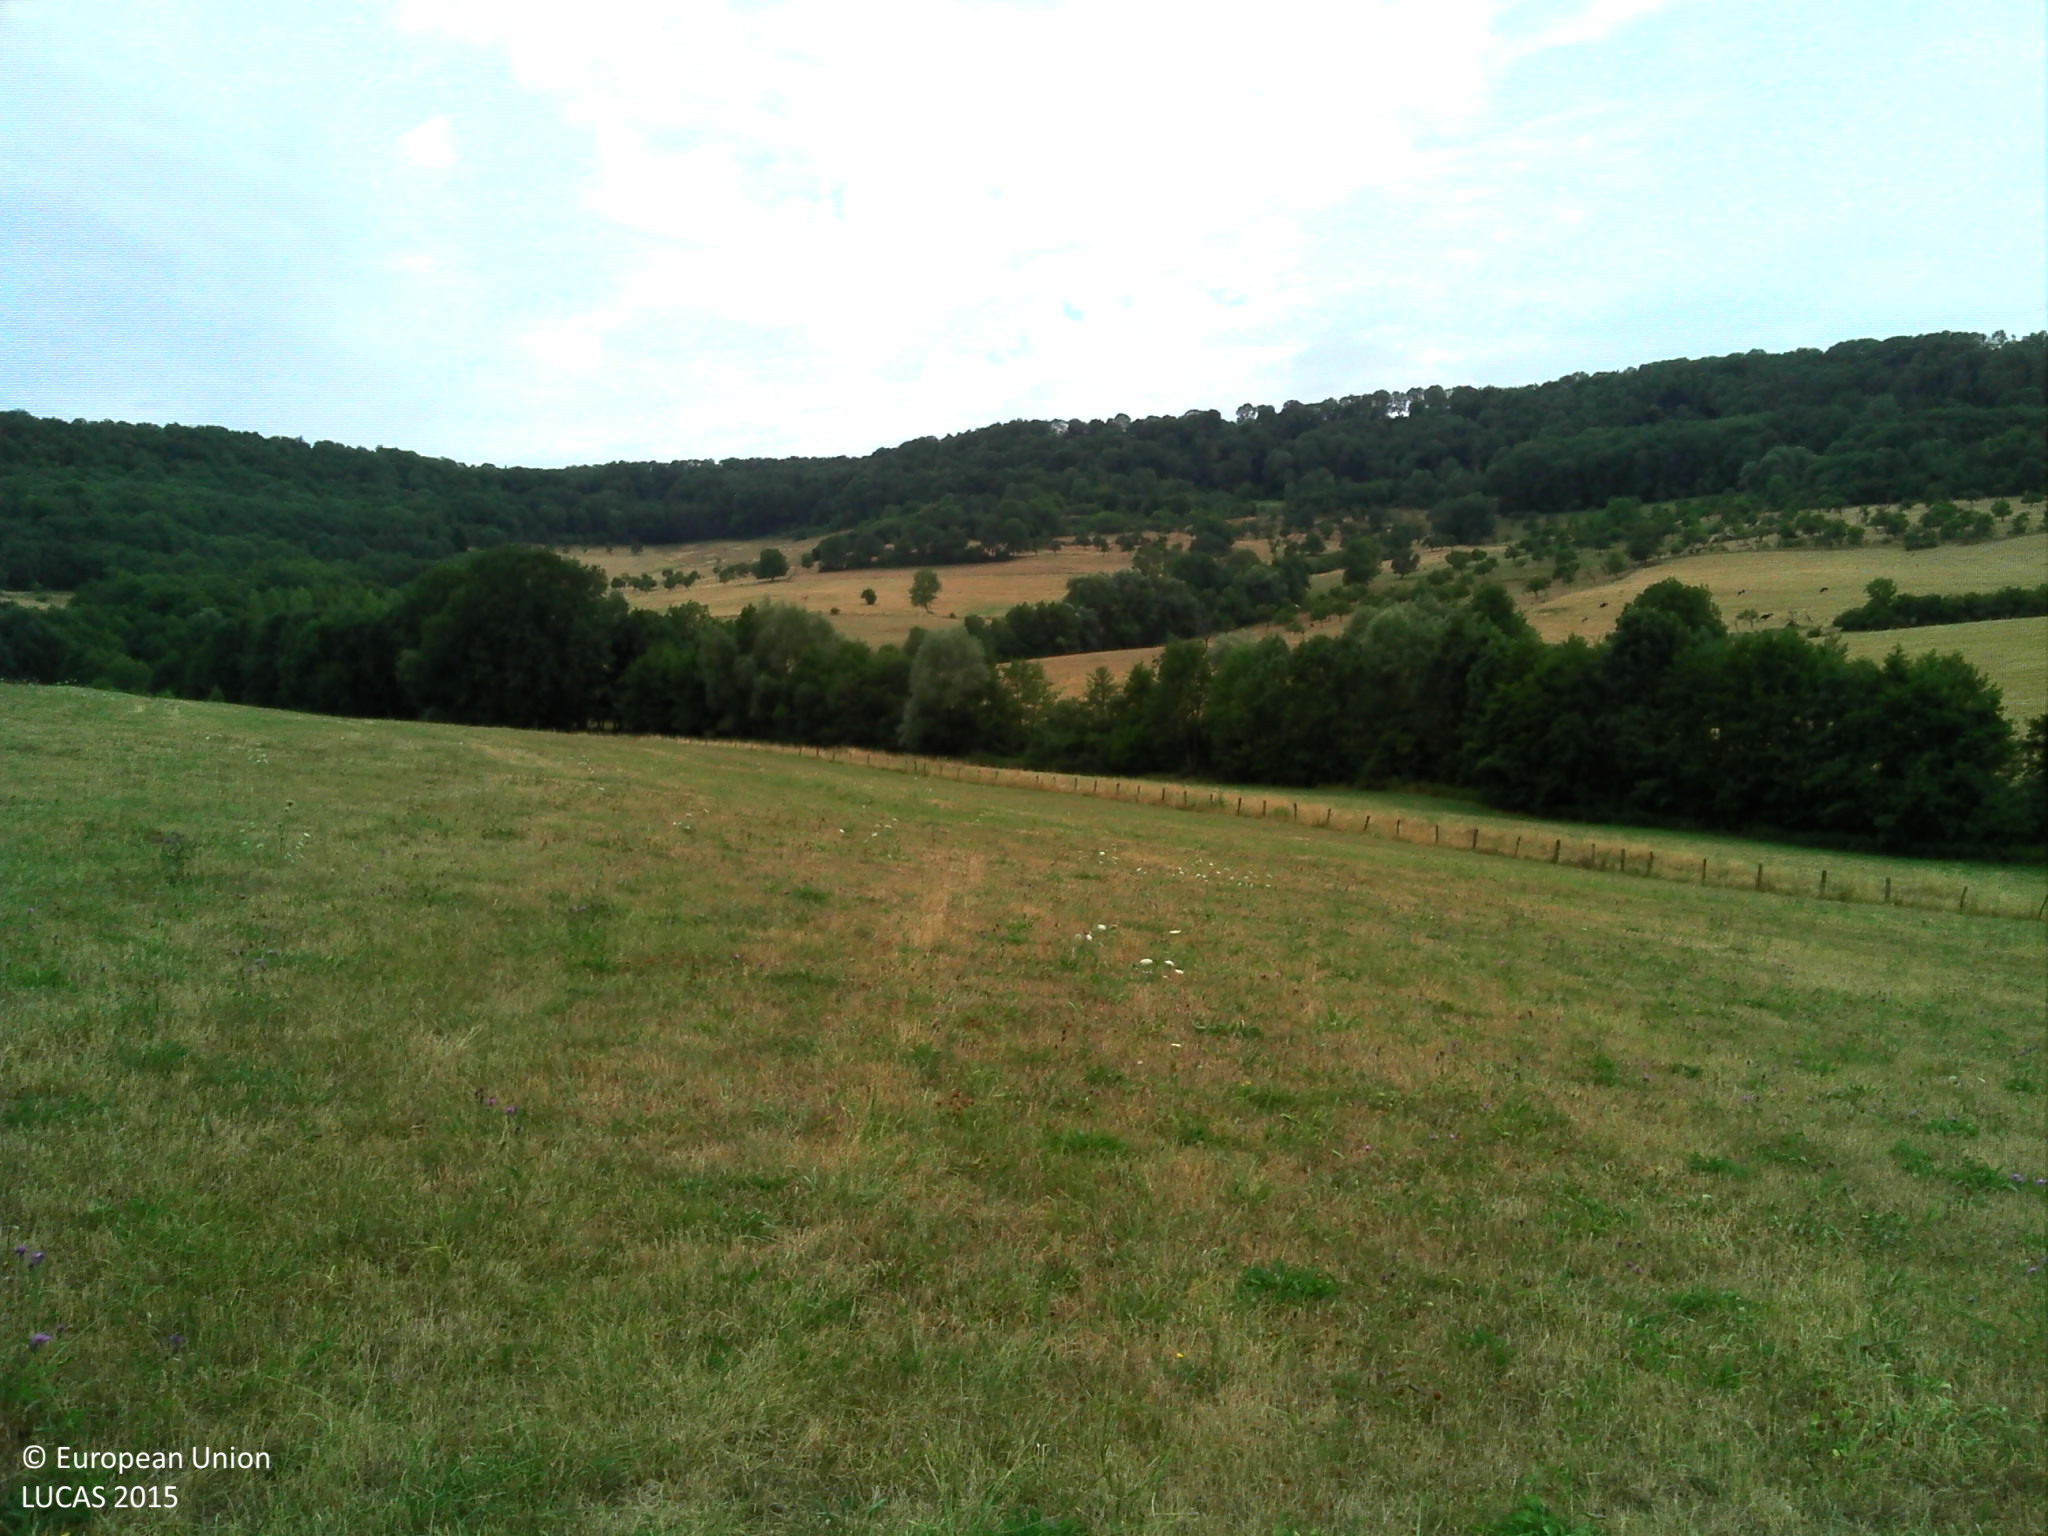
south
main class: Grassland
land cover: Grassland without tree/shrub cover
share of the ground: > 75 %
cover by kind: herbaceous plants 100 %
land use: Agriculture (excluding fallow land and kitchen gardens)
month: July
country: FR
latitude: 48.4237
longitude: 6.0677
